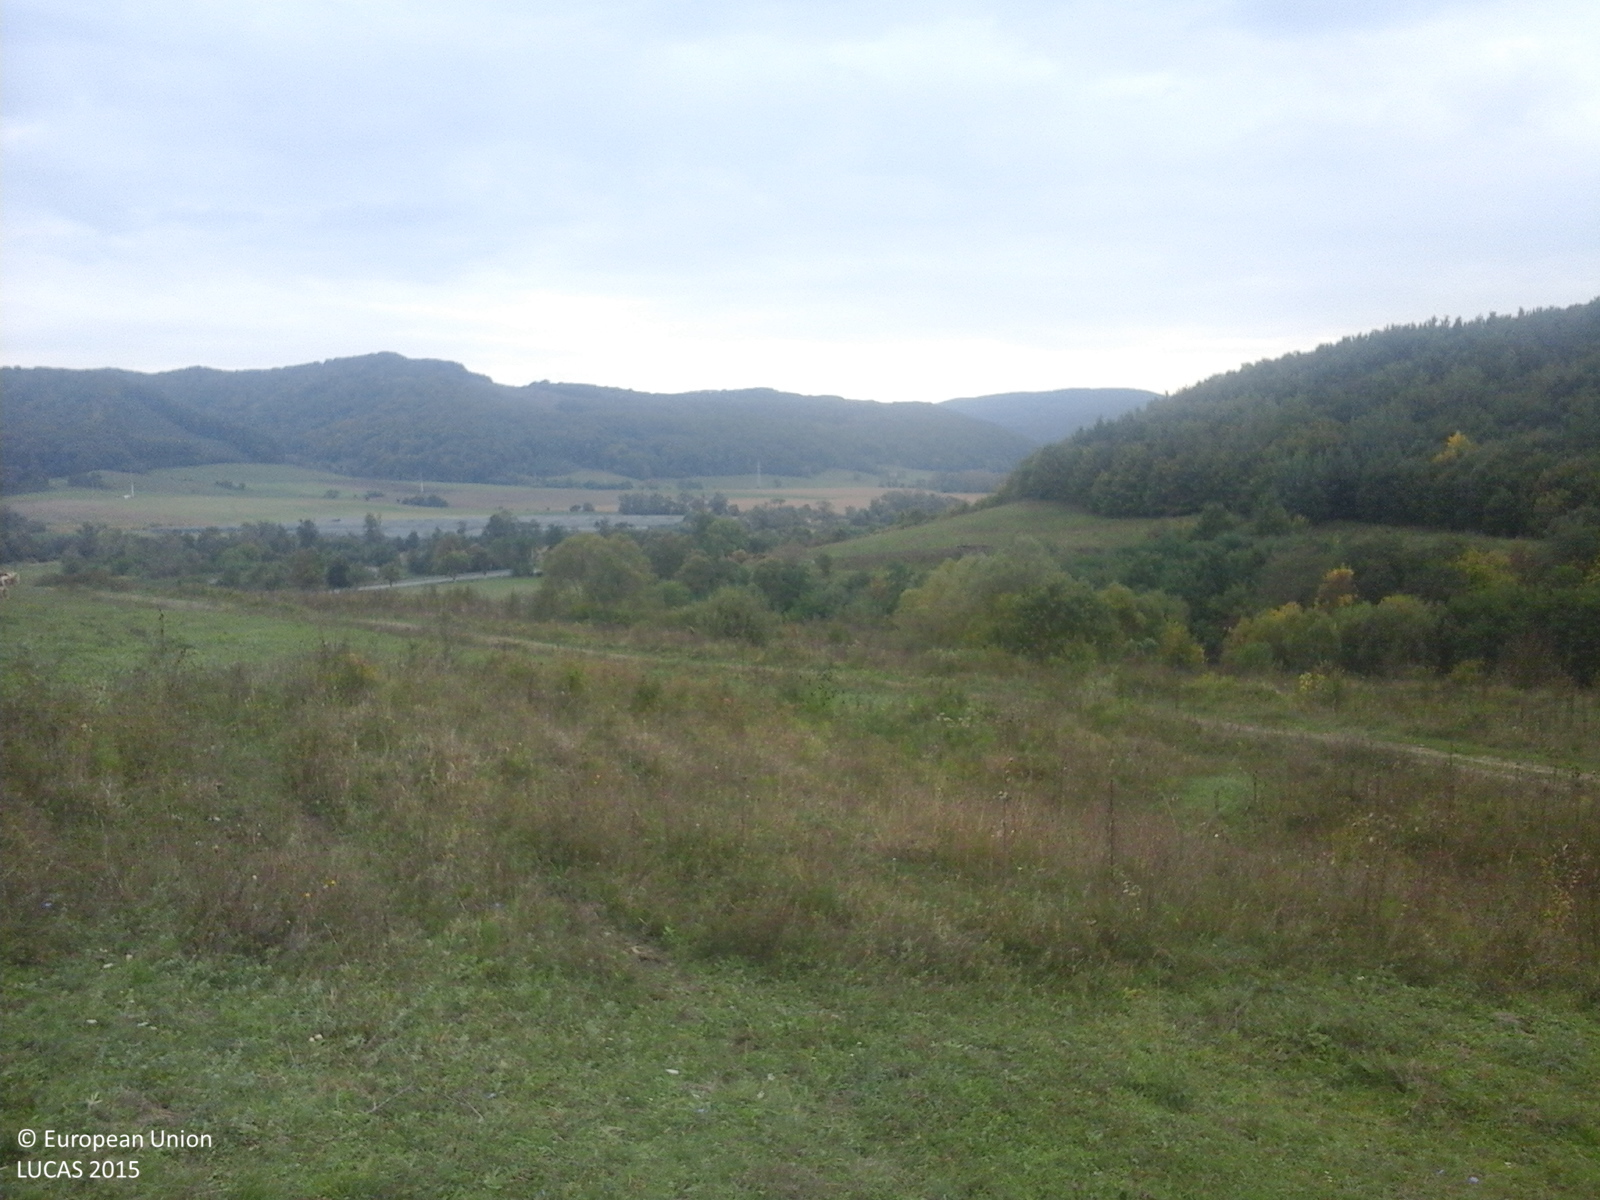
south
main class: Grassland
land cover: Grassland without tree/shrub cover
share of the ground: > 75 %
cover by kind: herbaceous plants 100 %
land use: Agriculture (excluding fallow land and kitchen gardens)
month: October
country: RO
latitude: 46.4573
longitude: 24.8721
